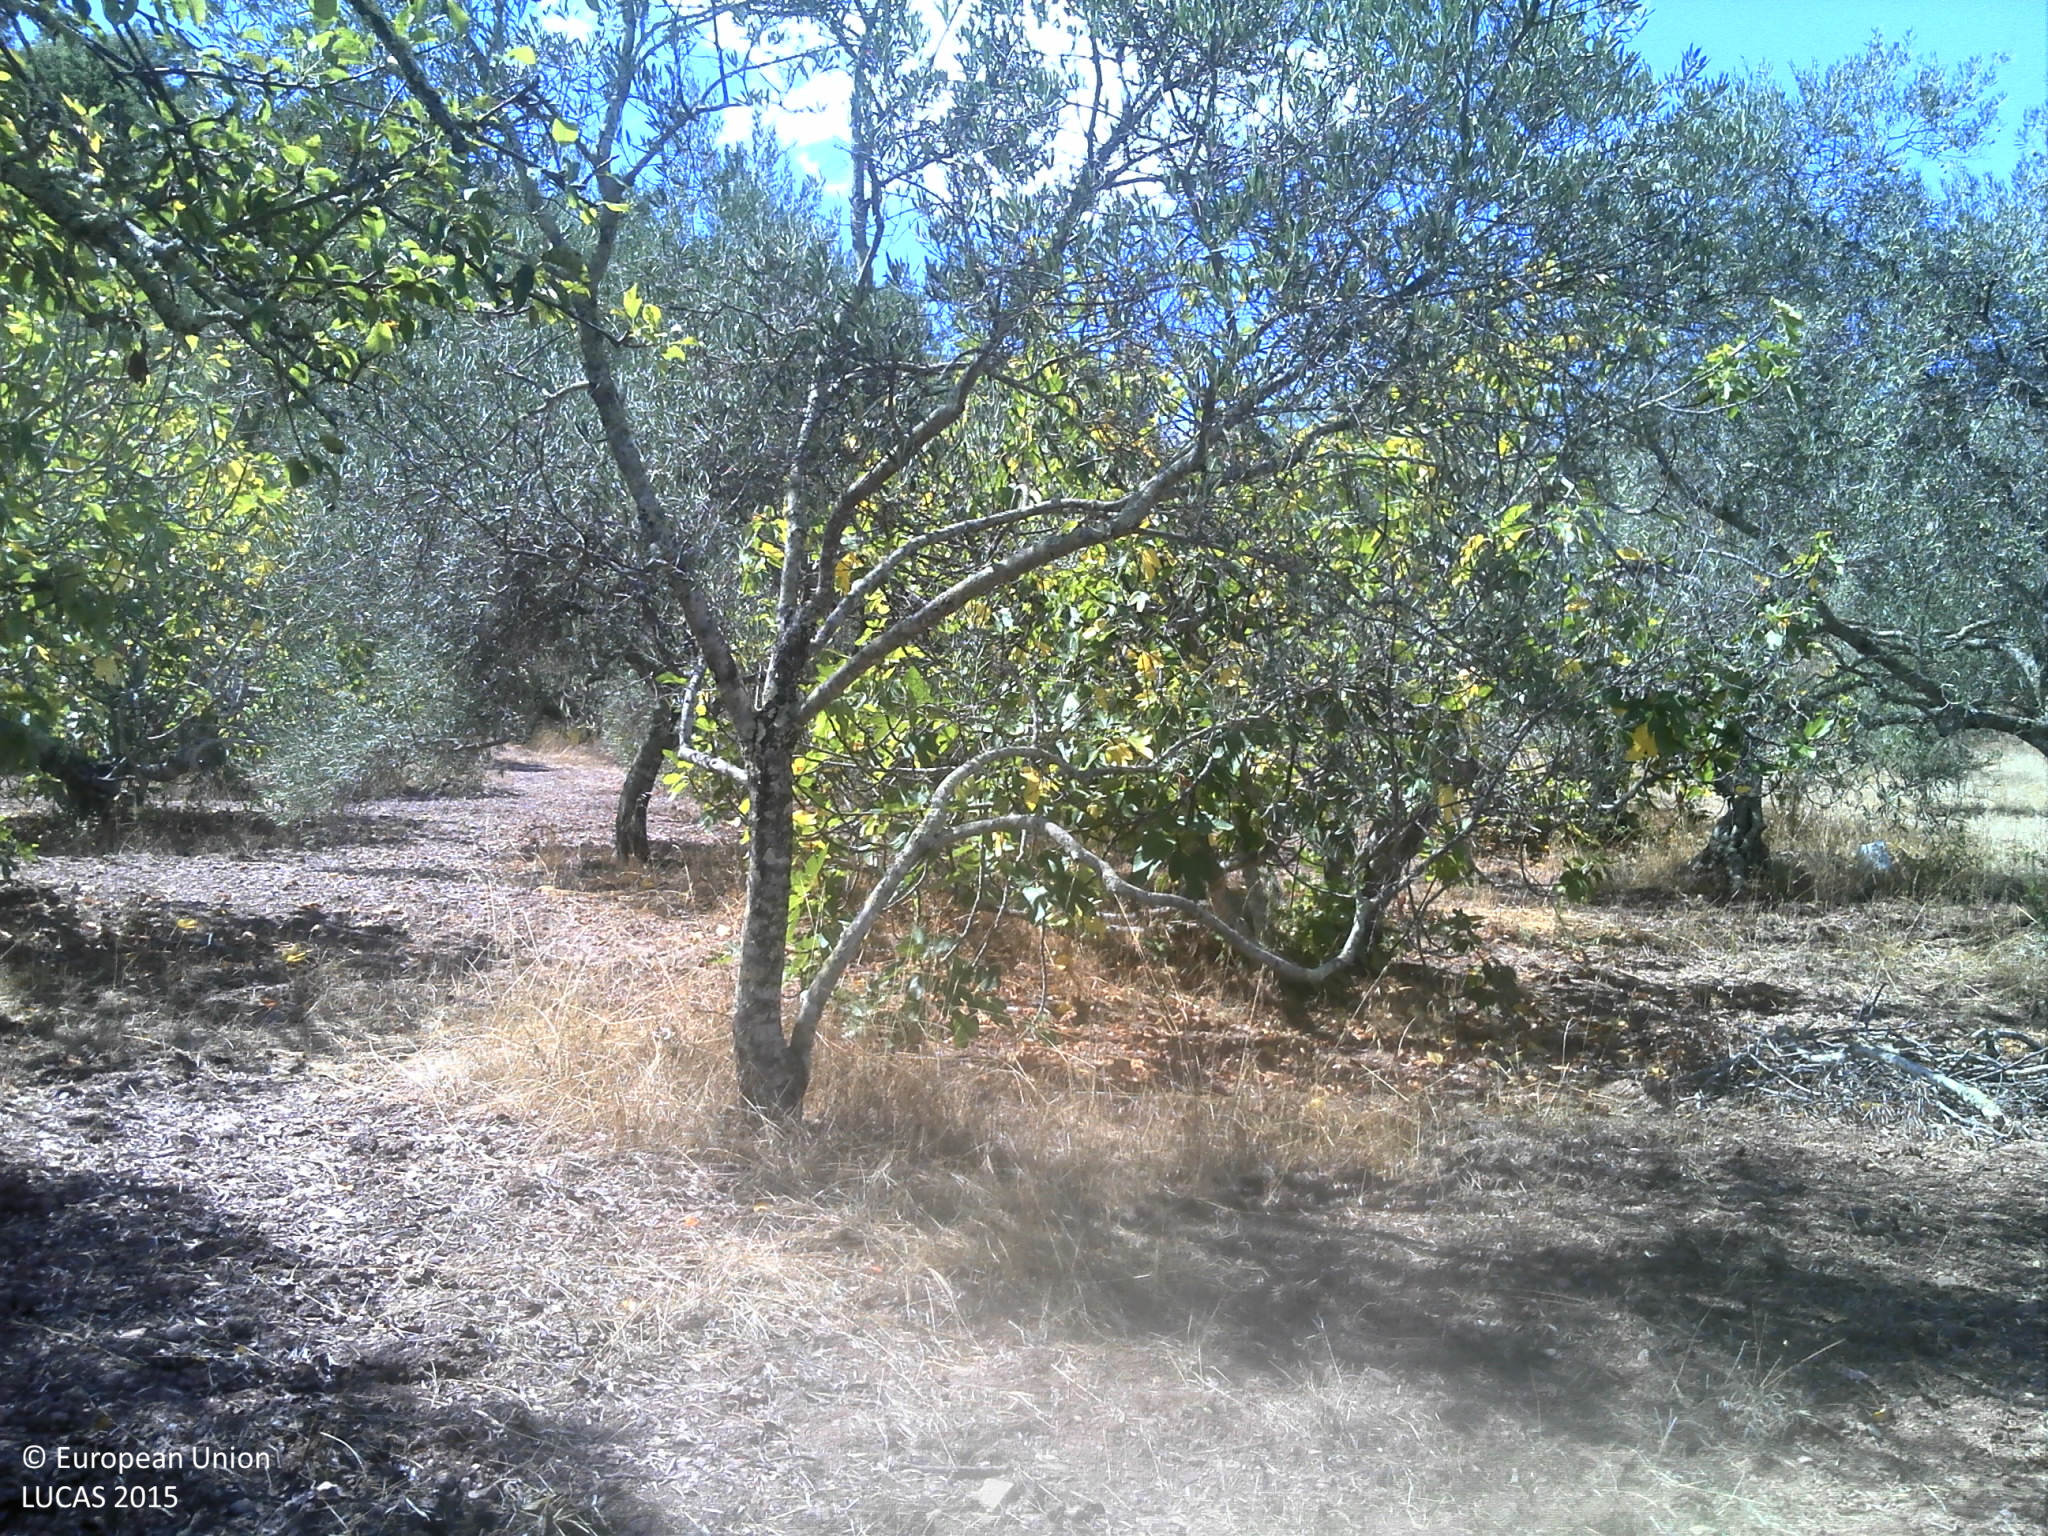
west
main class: Cropland
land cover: Pear fruit
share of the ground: 25 - 50 %
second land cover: Grassland without tree/shrub cover
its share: 25 - 50 %
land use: Agriculture (excluding fallow land and kitchen gardens)
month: September
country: PT
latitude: 37.3136
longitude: -8.1758
